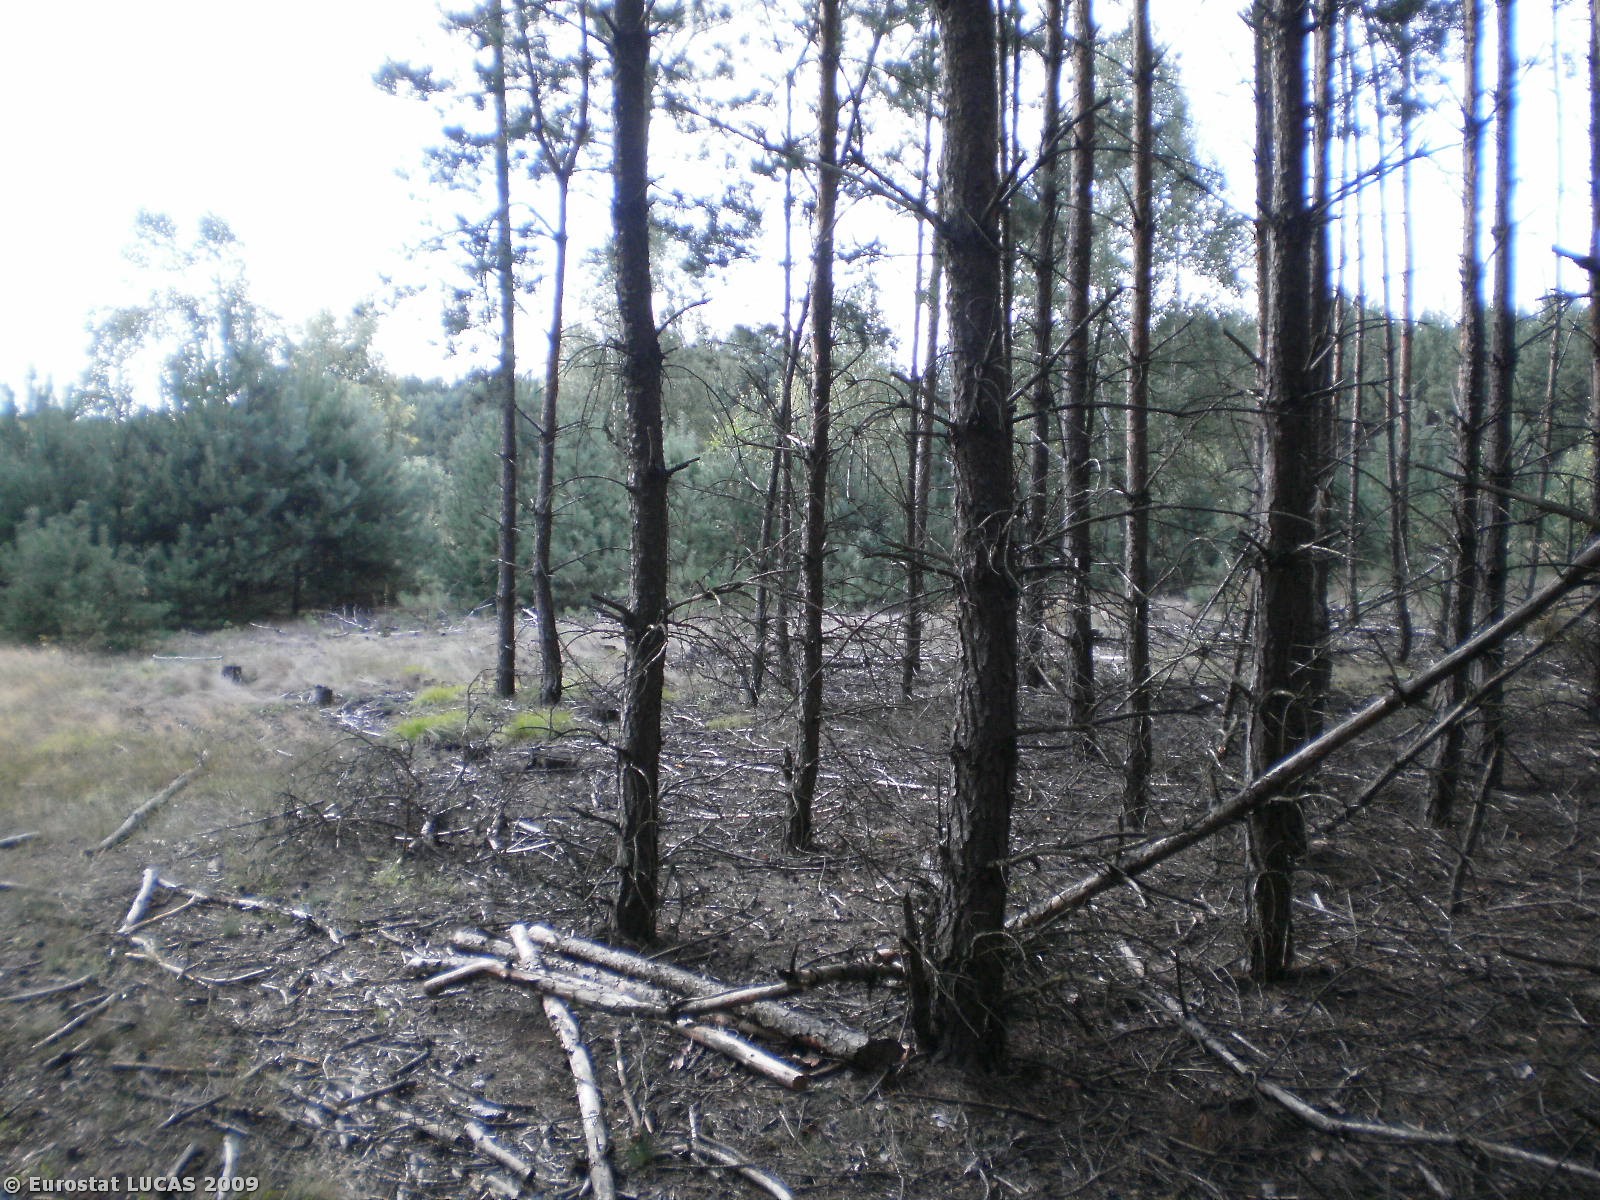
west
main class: Woodland
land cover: Coniferous woodland
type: hemiboreal forest and nemoral coniferous forest and mixed broadleaved-coniferous forest
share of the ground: > 75 %
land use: Forestry
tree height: > 5 m
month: August
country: PL
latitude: 52.8586
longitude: 21.8031
